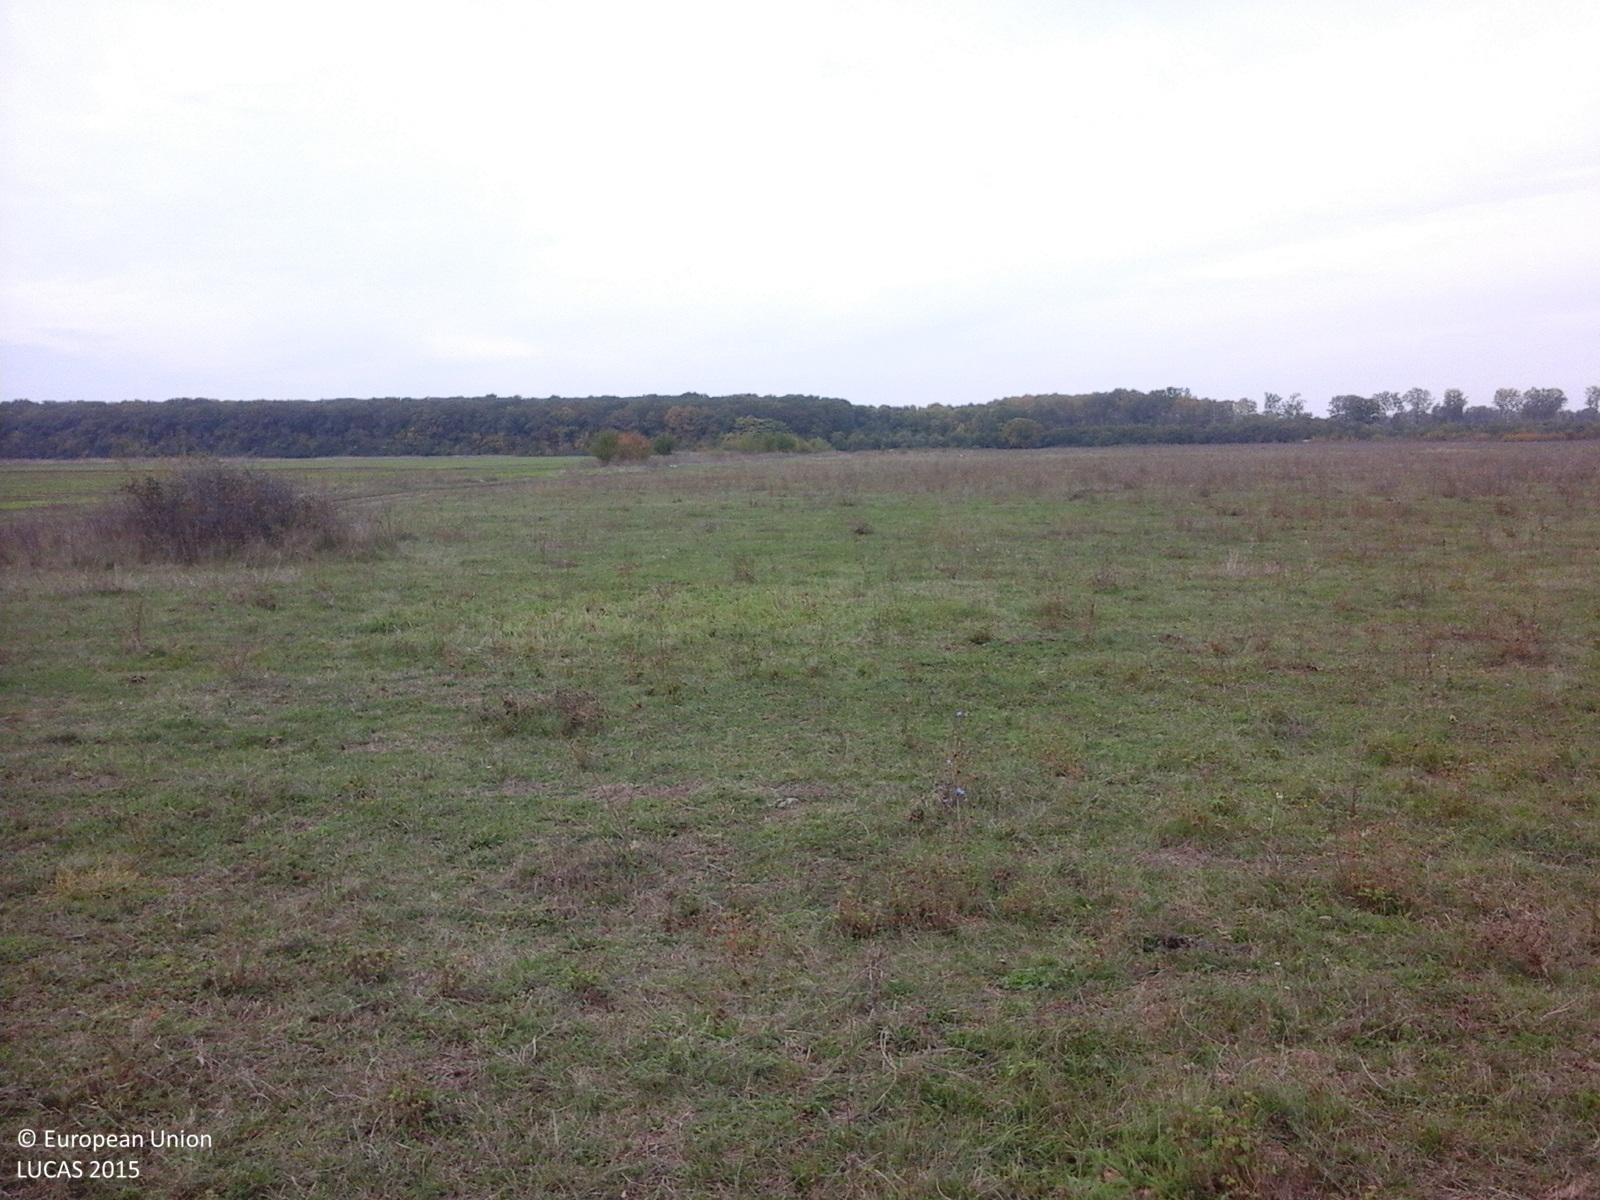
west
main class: Grassland
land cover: Spontaneously vegetated surfaces
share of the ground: > 75 %
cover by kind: herbaceous plants 100 %
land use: Agriculture (excluding fallow land and kitchen gardens)
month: October
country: RO
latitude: 44.7972
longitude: 26.1777
